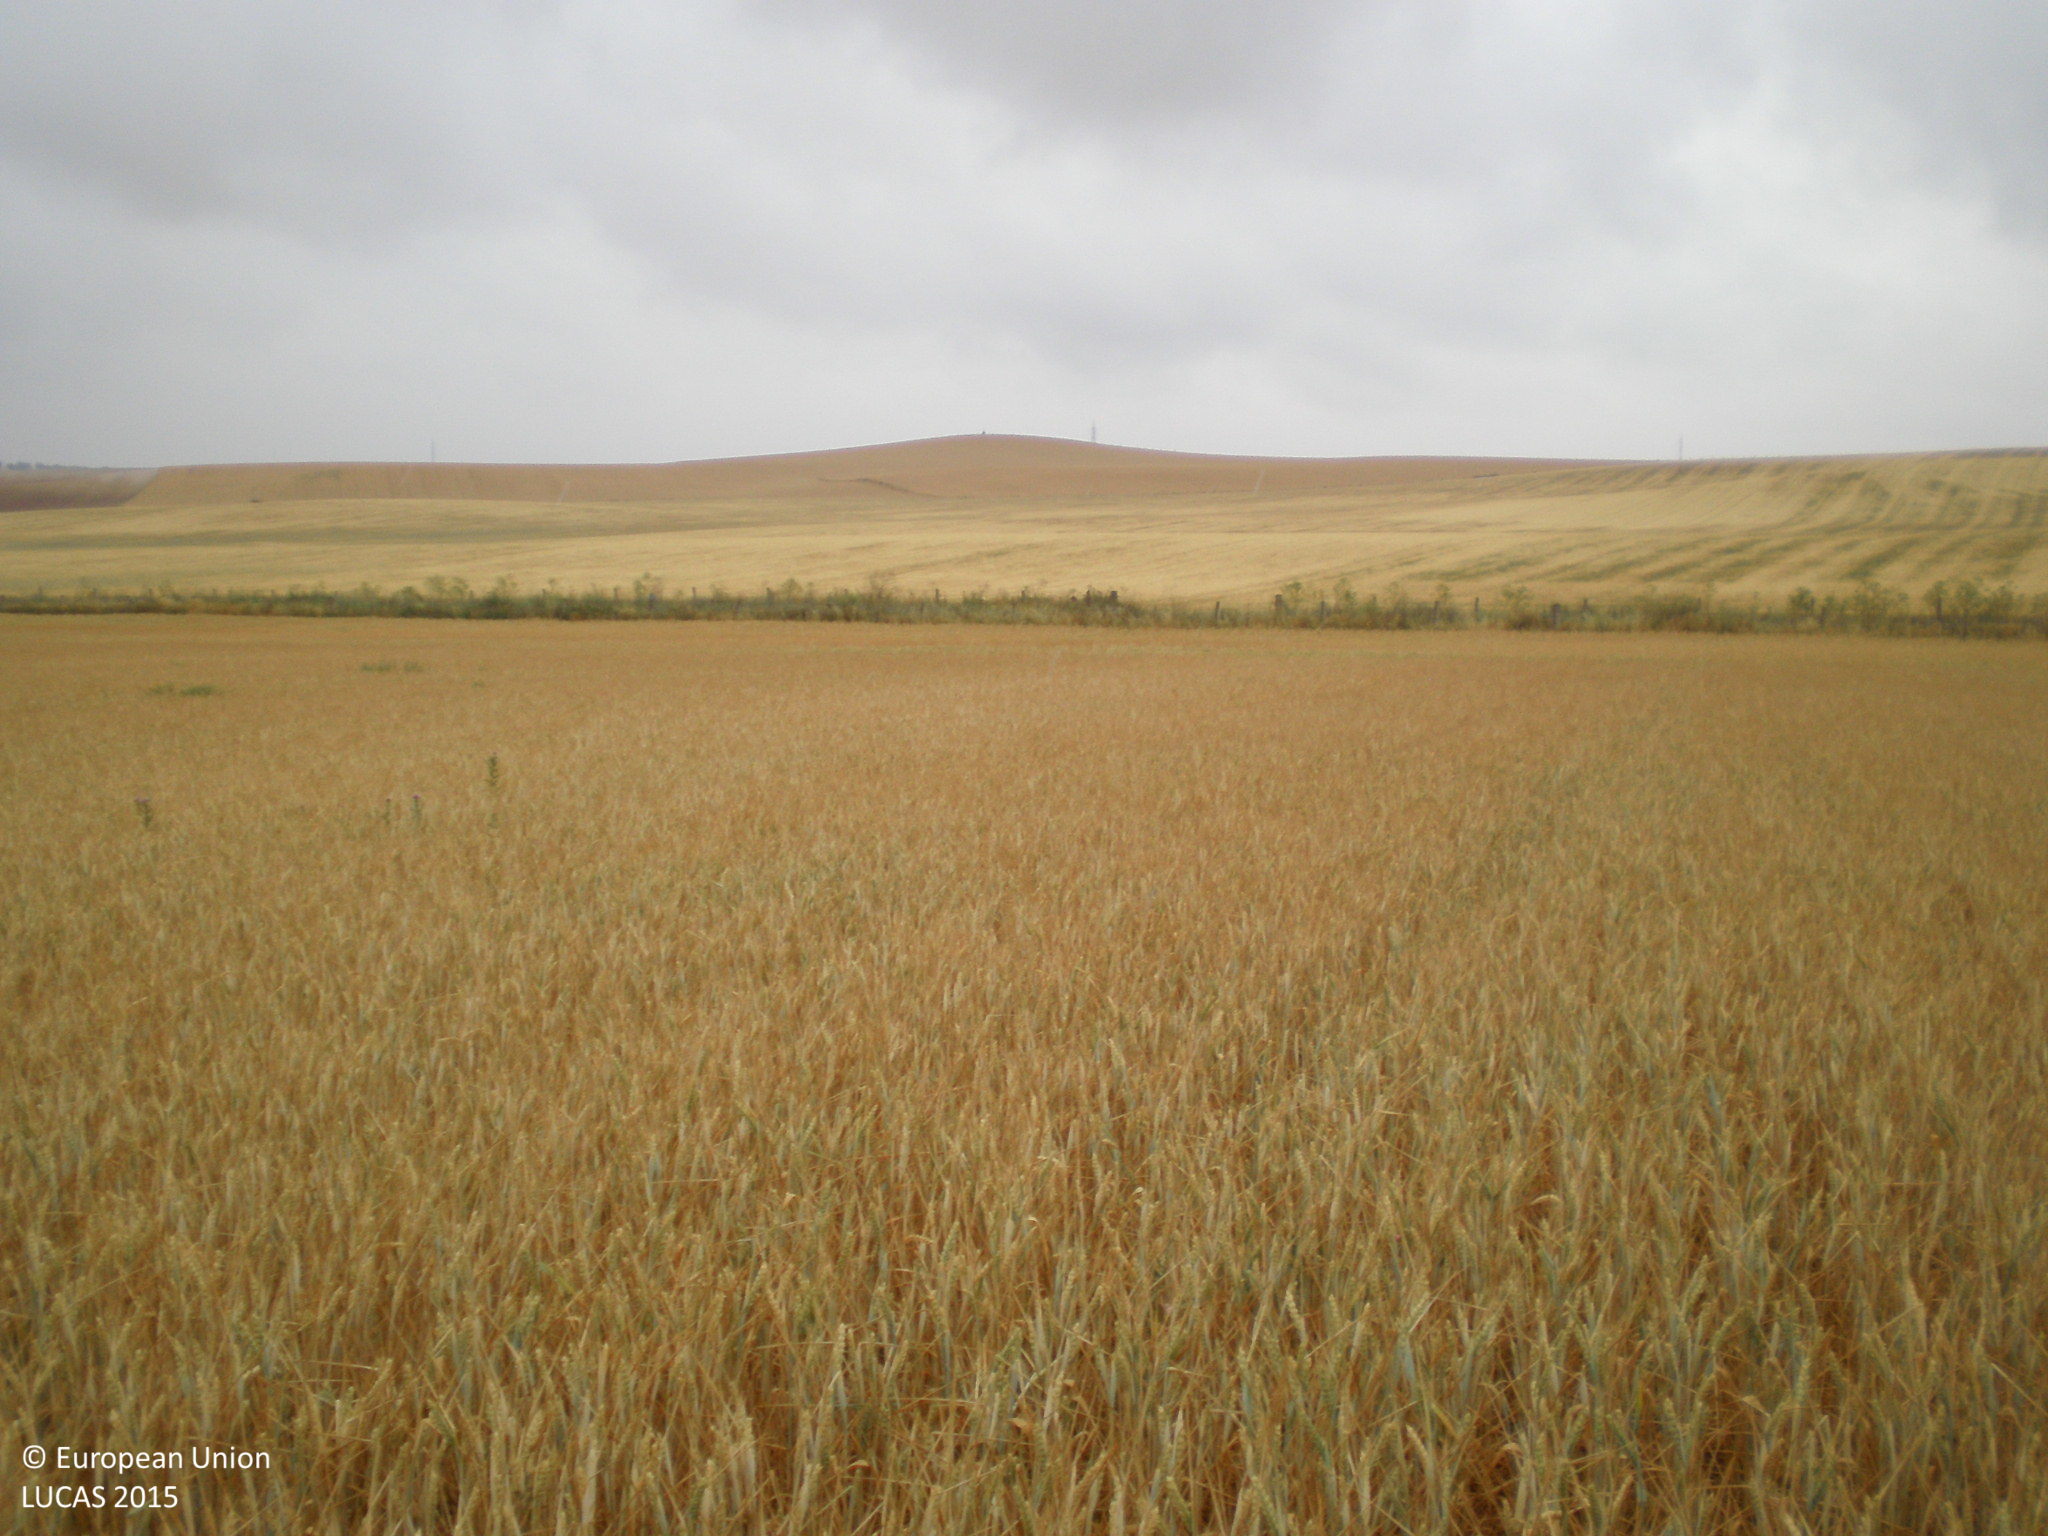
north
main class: Cropland
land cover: Common wheat
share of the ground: > 75 %
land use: Agriculture (excluding fallow land and kitchen gardens)
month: June
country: ES
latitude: 40.9714
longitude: -5.7532
